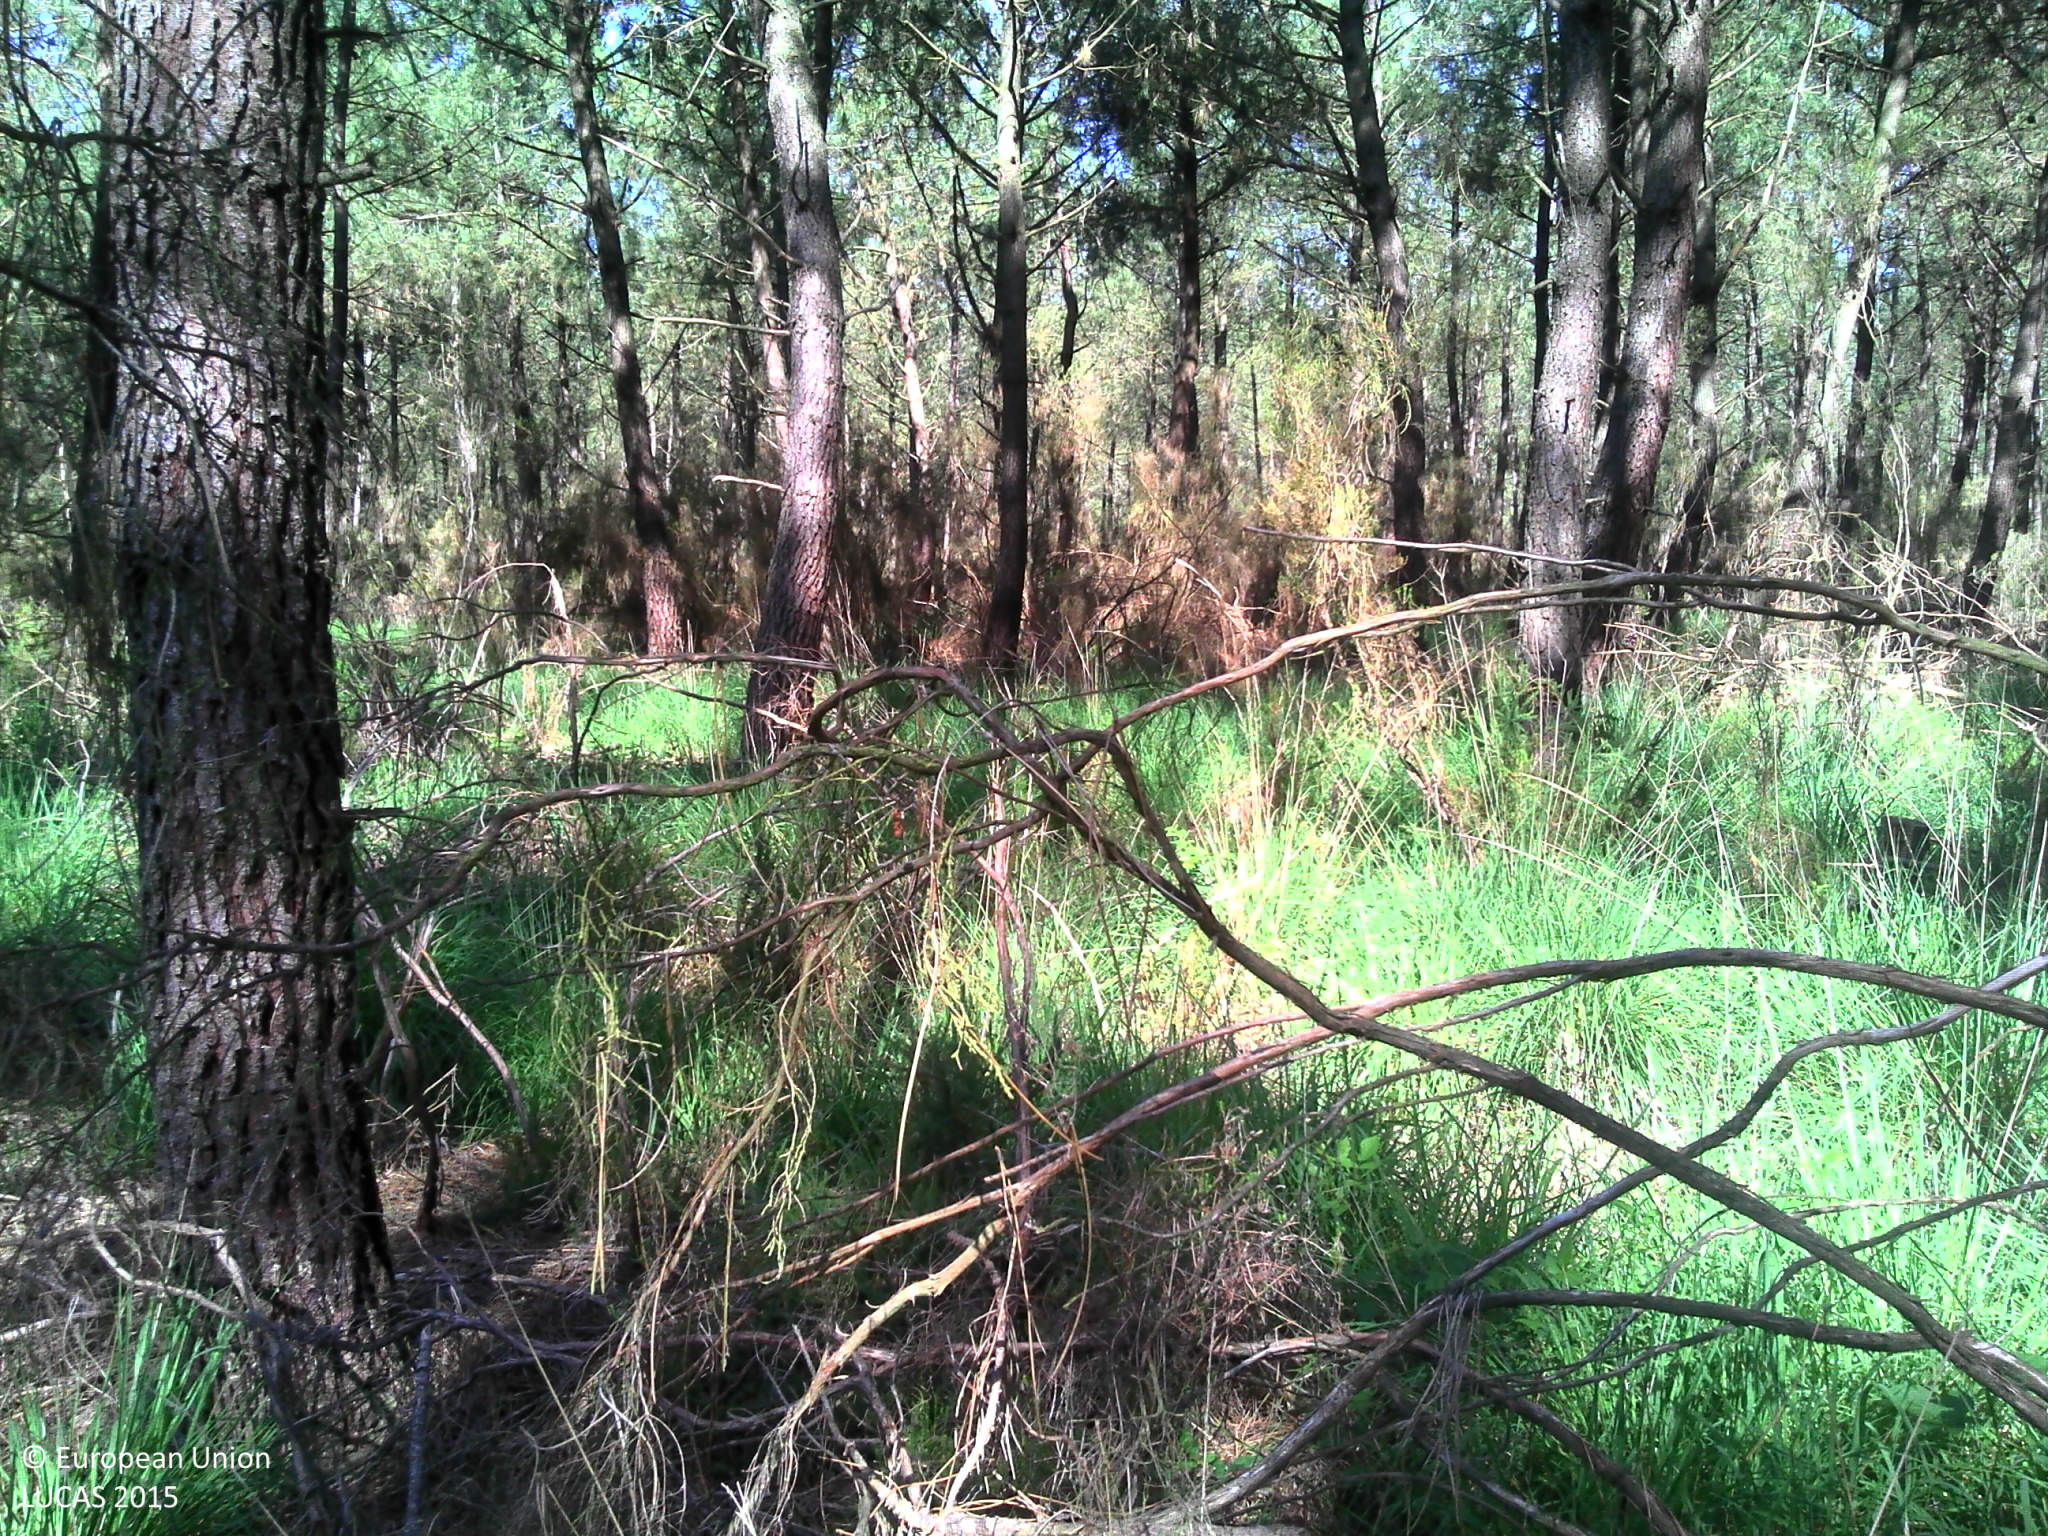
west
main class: Woodland
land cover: Pine dominated coniferous woodland
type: boreal forest
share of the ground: > 75 %
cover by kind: coniferous forest trees 85 %, herbaceous plants 10 %, shrubs 5 %
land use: Forestry
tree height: > 5 m
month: June
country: FR
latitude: 46.6891
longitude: 0.5020
